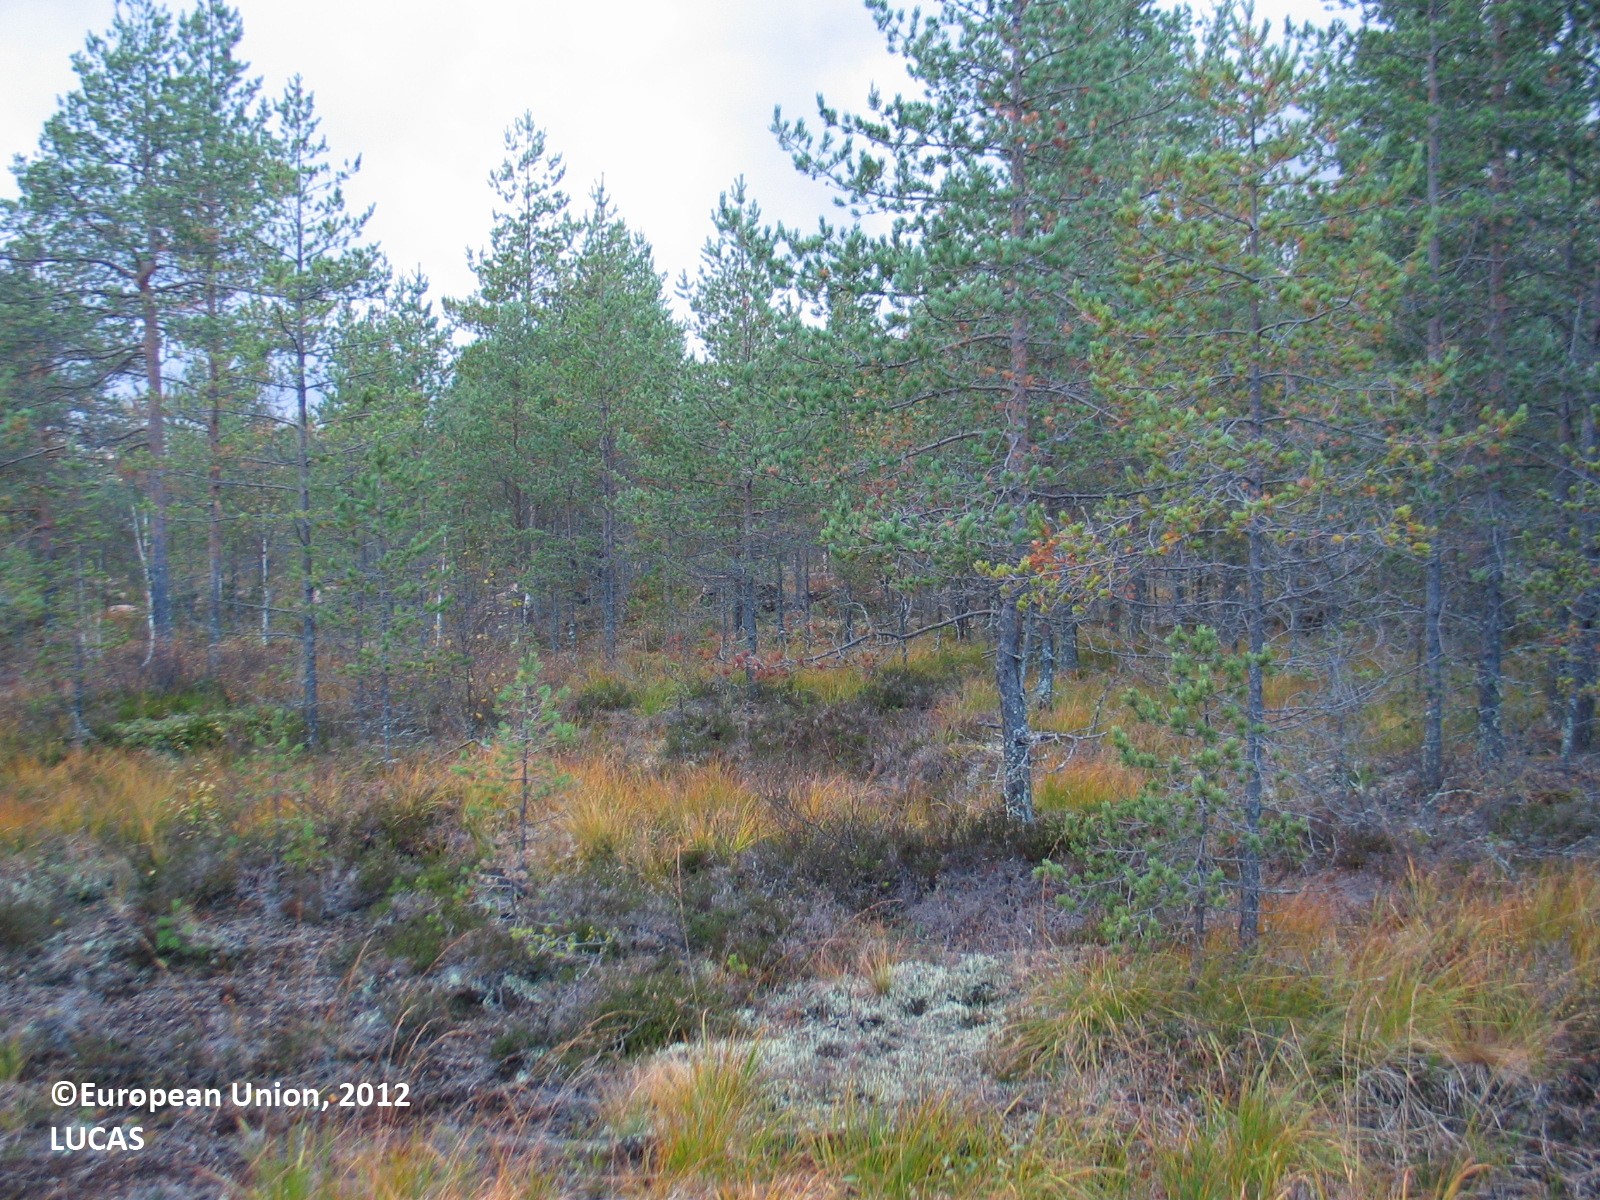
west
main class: Woodland
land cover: Pine dominated coniferous woodland
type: mire and swamp forests
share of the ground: 25 - 50 %
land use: Forestry
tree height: > 5 m
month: September
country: FI
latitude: 65.5402
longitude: 25.6425
